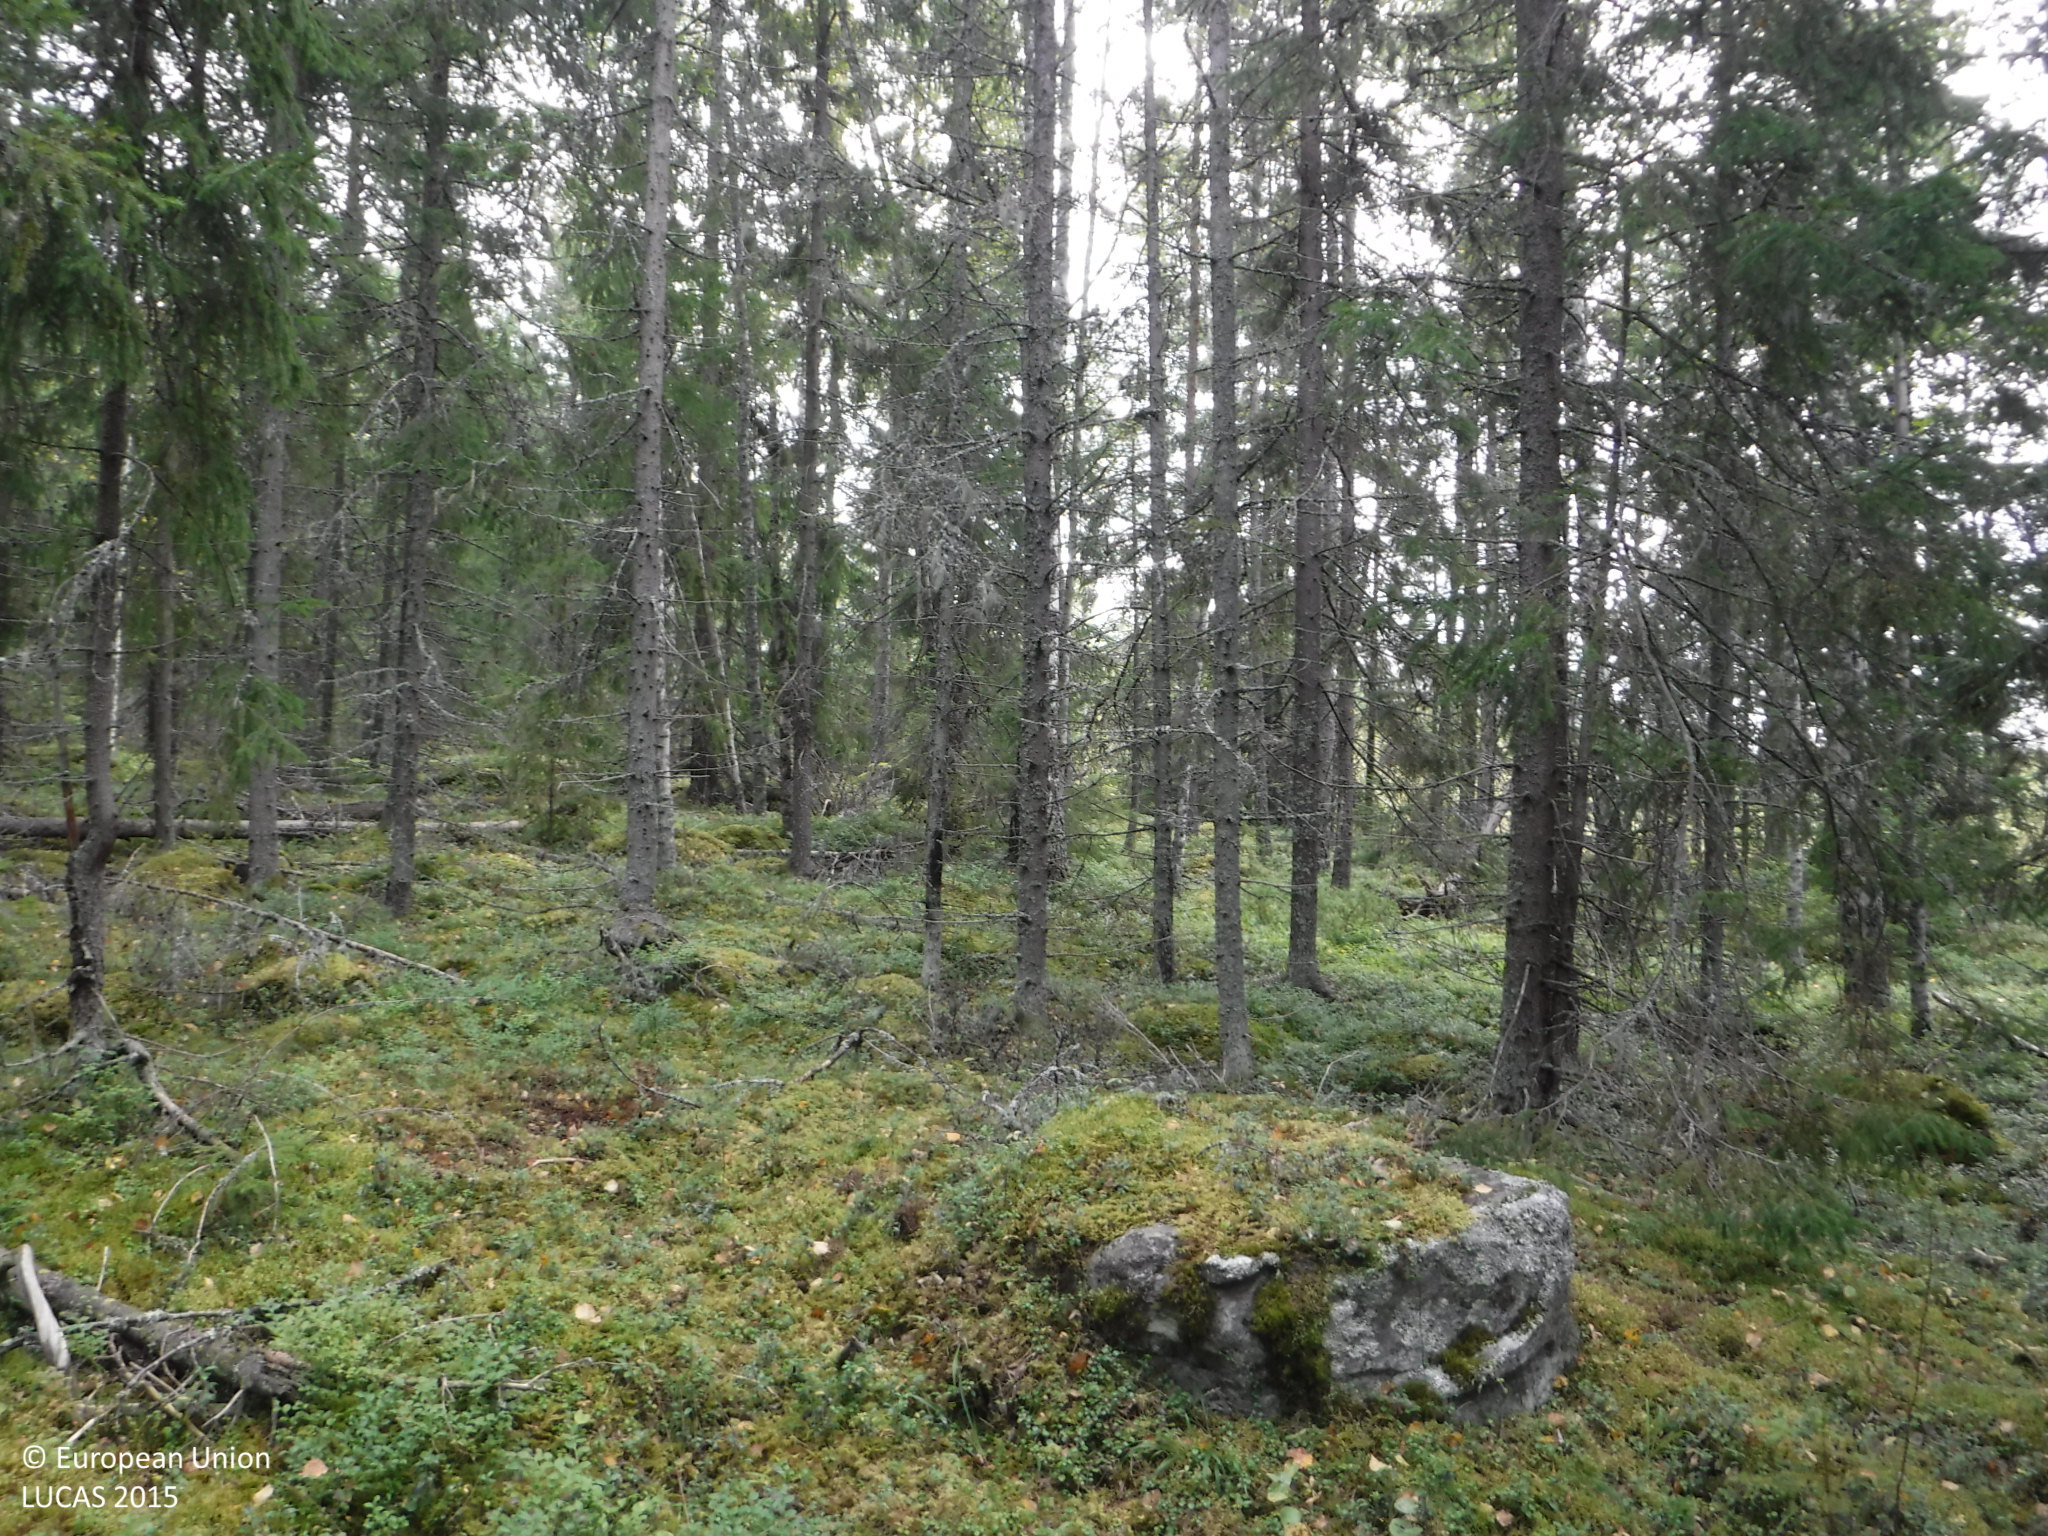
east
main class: Woodland
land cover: Spruce dominated mixed woodland
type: boreal forest
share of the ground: 50 - 75 %
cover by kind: coniferous forest trees 30 %, broadleaved forest trees 25 %, shrubs 25 %, lichens and mosses 20 %
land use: Forestry
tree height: > 5 m
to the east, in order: Spruce dominated mixed woodland; Ditches and canals; Abandoned hedges; Tracks; Lines of trees; Ditches and canals; Broadleaved woodland; Pine dominated coniferous woodland
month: August
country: FI
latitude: 61.2153
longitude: 21.5771
